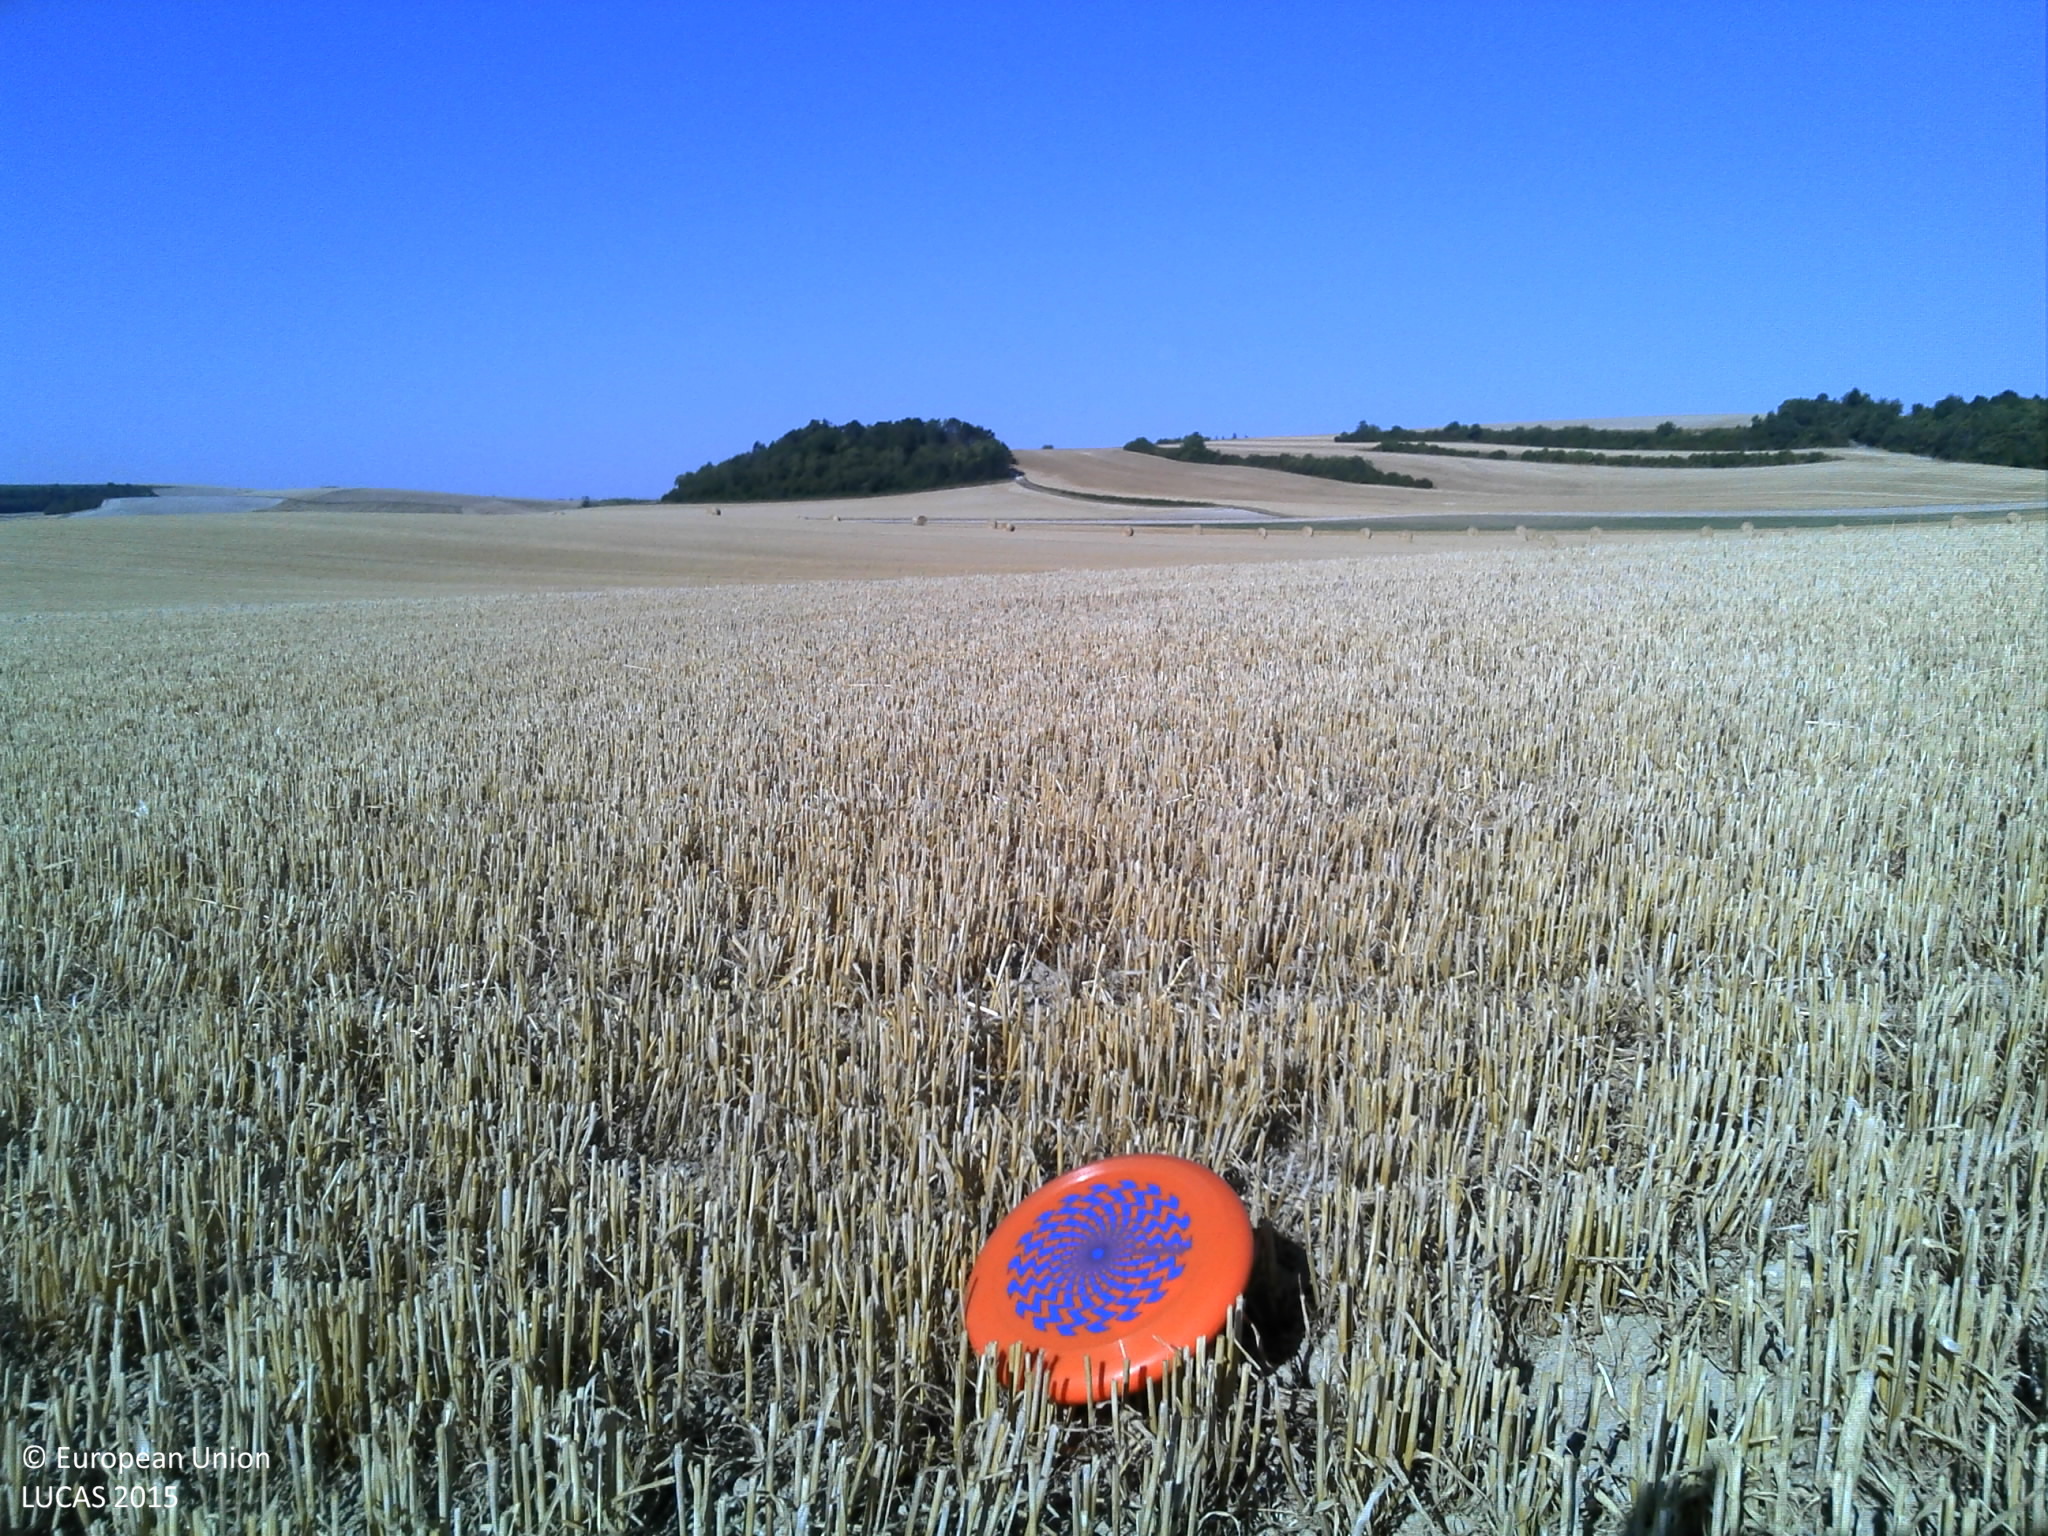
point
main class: Cropland
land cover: Barley
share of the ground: > 75 %
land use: Agriculture (excluding fallow land and kitchen gardens)
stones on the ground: < 10 %
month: August
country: FR
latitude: 49.1453
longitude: 4.7742
